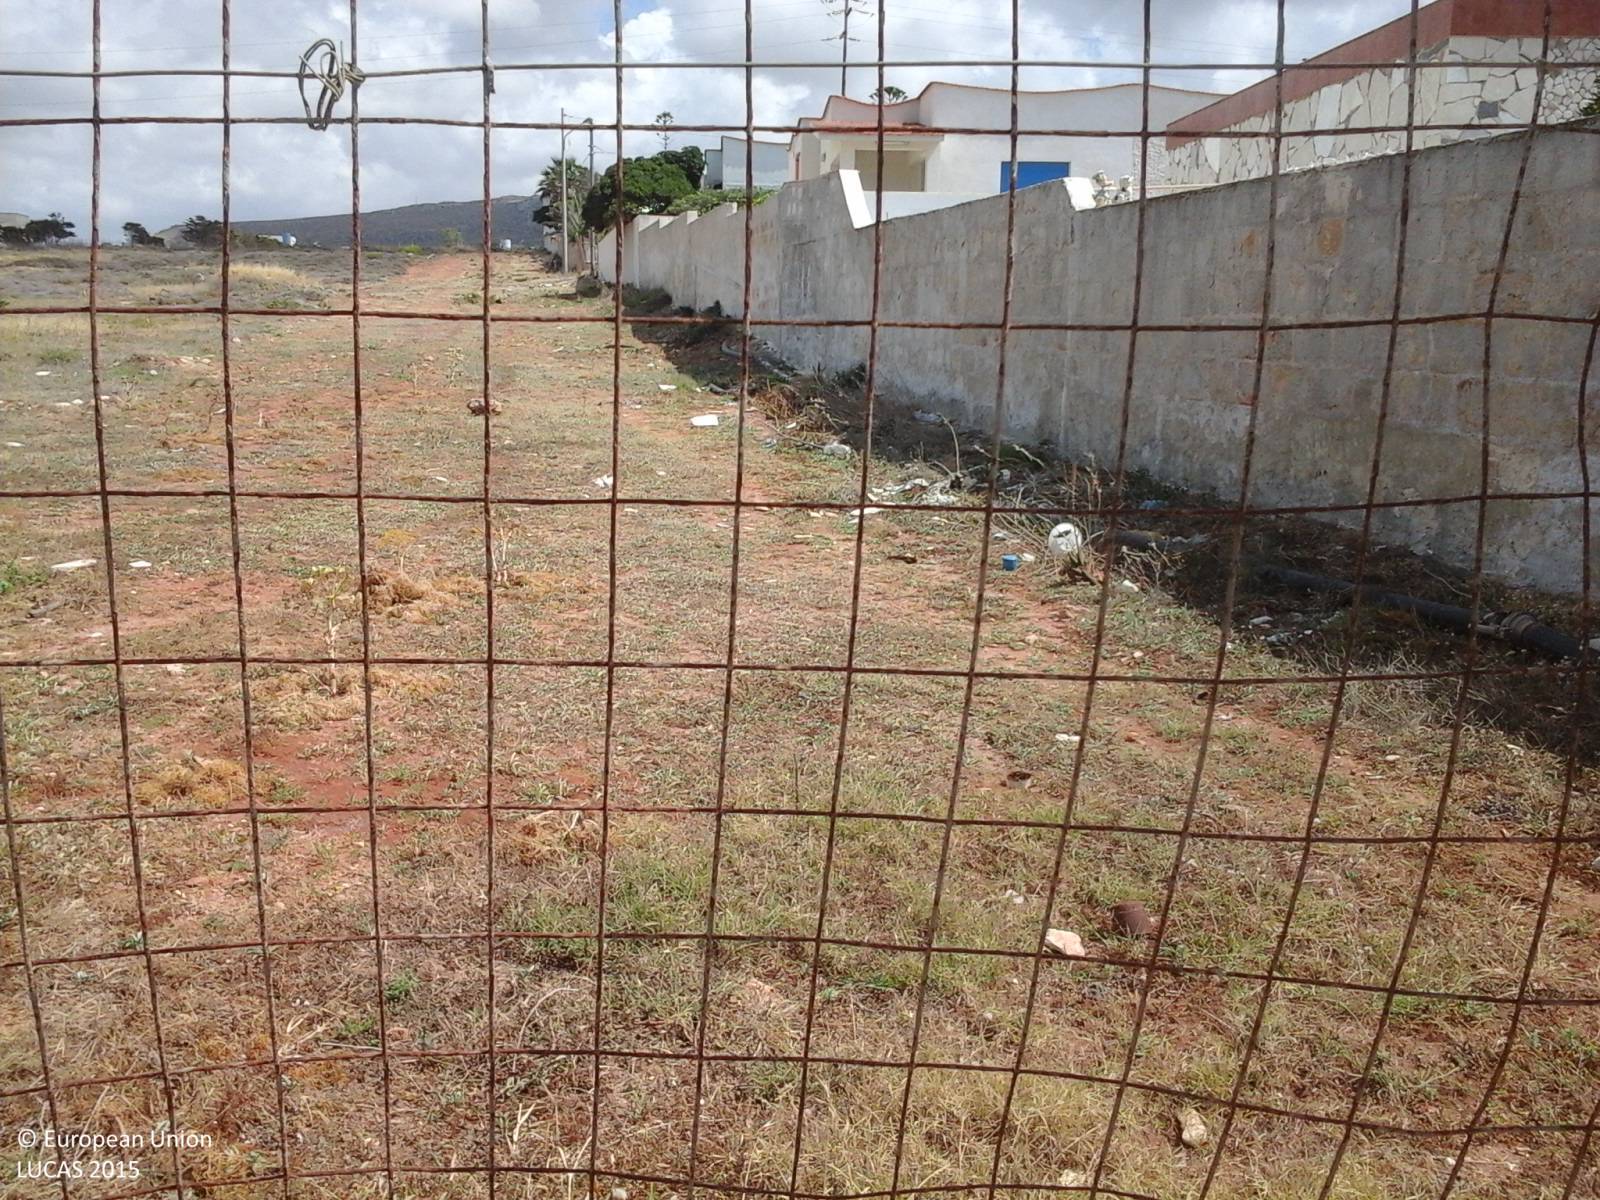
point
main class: Grassland
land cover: Spontaneously vegetated surfaces
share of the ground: > 75 %
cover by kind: herbaceous plants 100 %
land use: Semi-natural and natural areas not in use
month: June
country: IT
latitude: 38.0742
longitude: 12.6372
